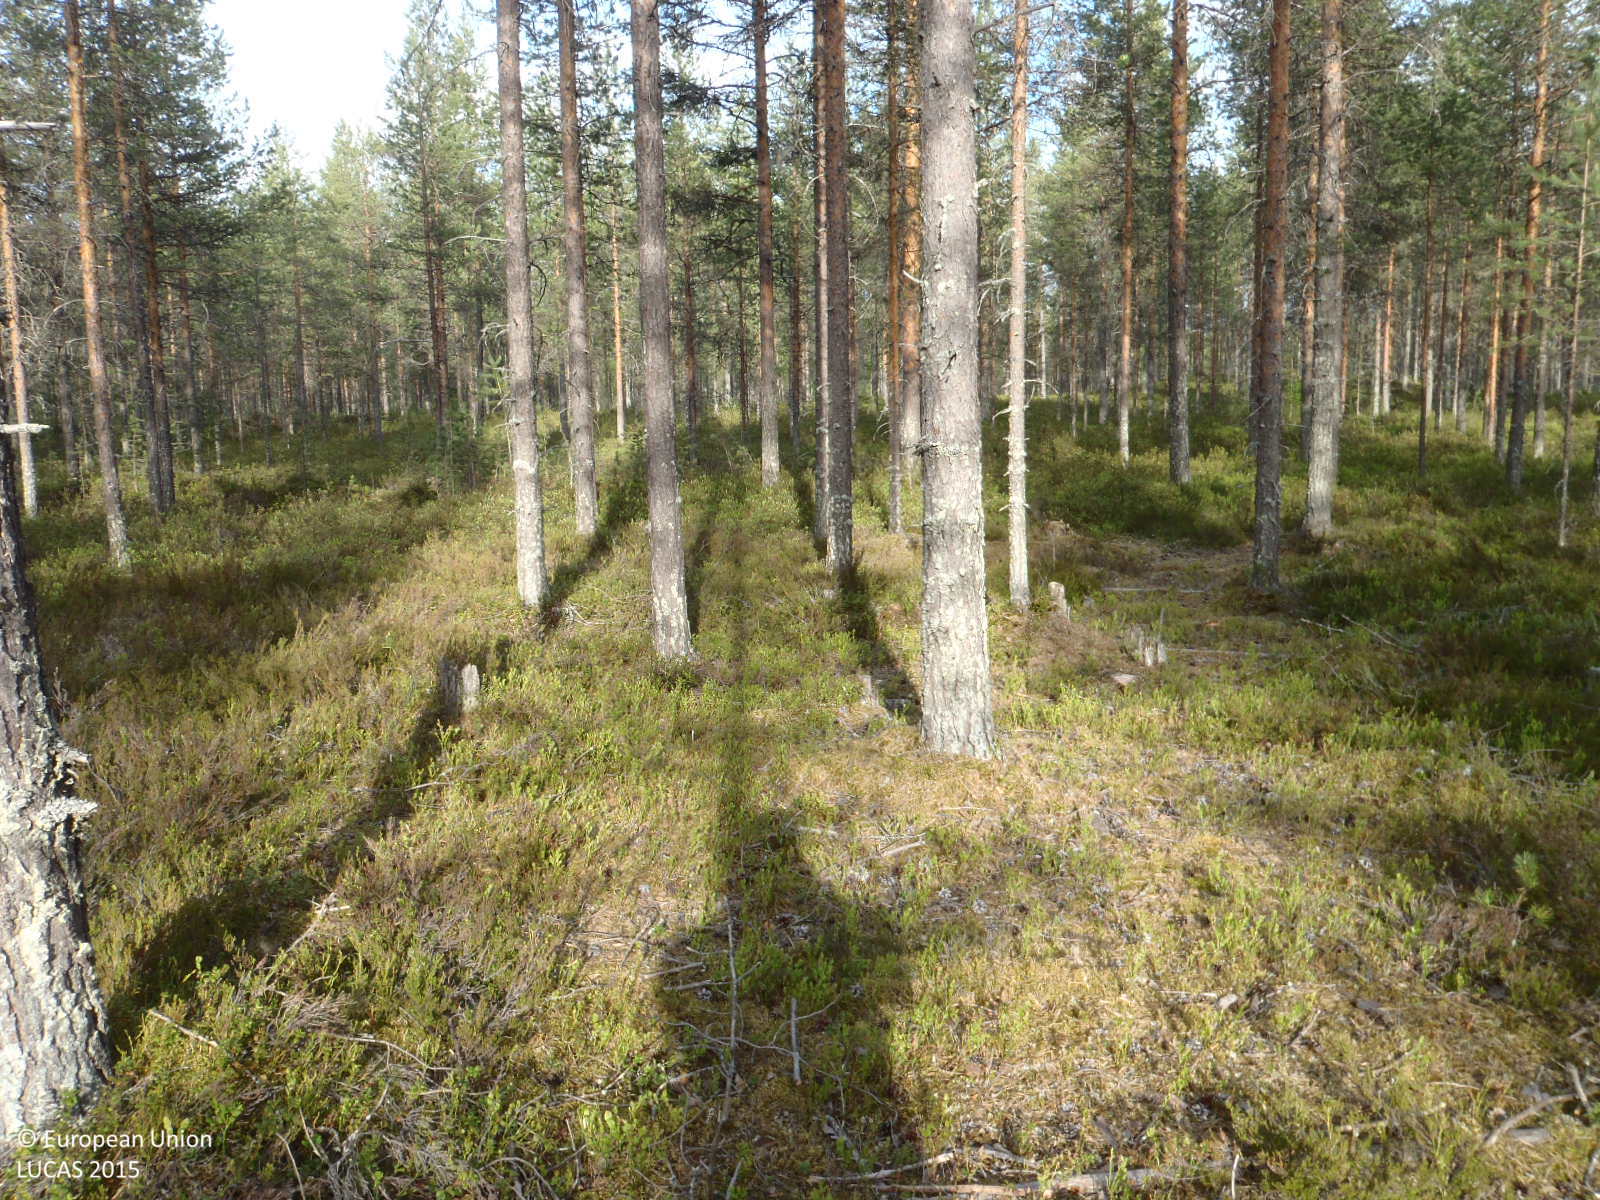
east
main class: Woodland
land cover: Pine dominated coniferous woodland
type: boreal forest
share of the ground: 50 - 75 %
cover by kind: coniferous forest trees 70 %, shrubs 25 %, lichens and mosses 5 %
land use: Forestry
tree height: > 5 m
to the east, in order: Pine dominated coniferous woodland; Ditches and canals; Pine dominated coniferous woodland; Ditches and canals; Pine dominated coniferous woodland; Ditches and canals; Pine dominated mixed woodland; Inland fresh running water; Other mixed woodland; Pine dominated mixed woodland
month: June
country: FI
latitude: 65.2665
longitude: 26.8869
